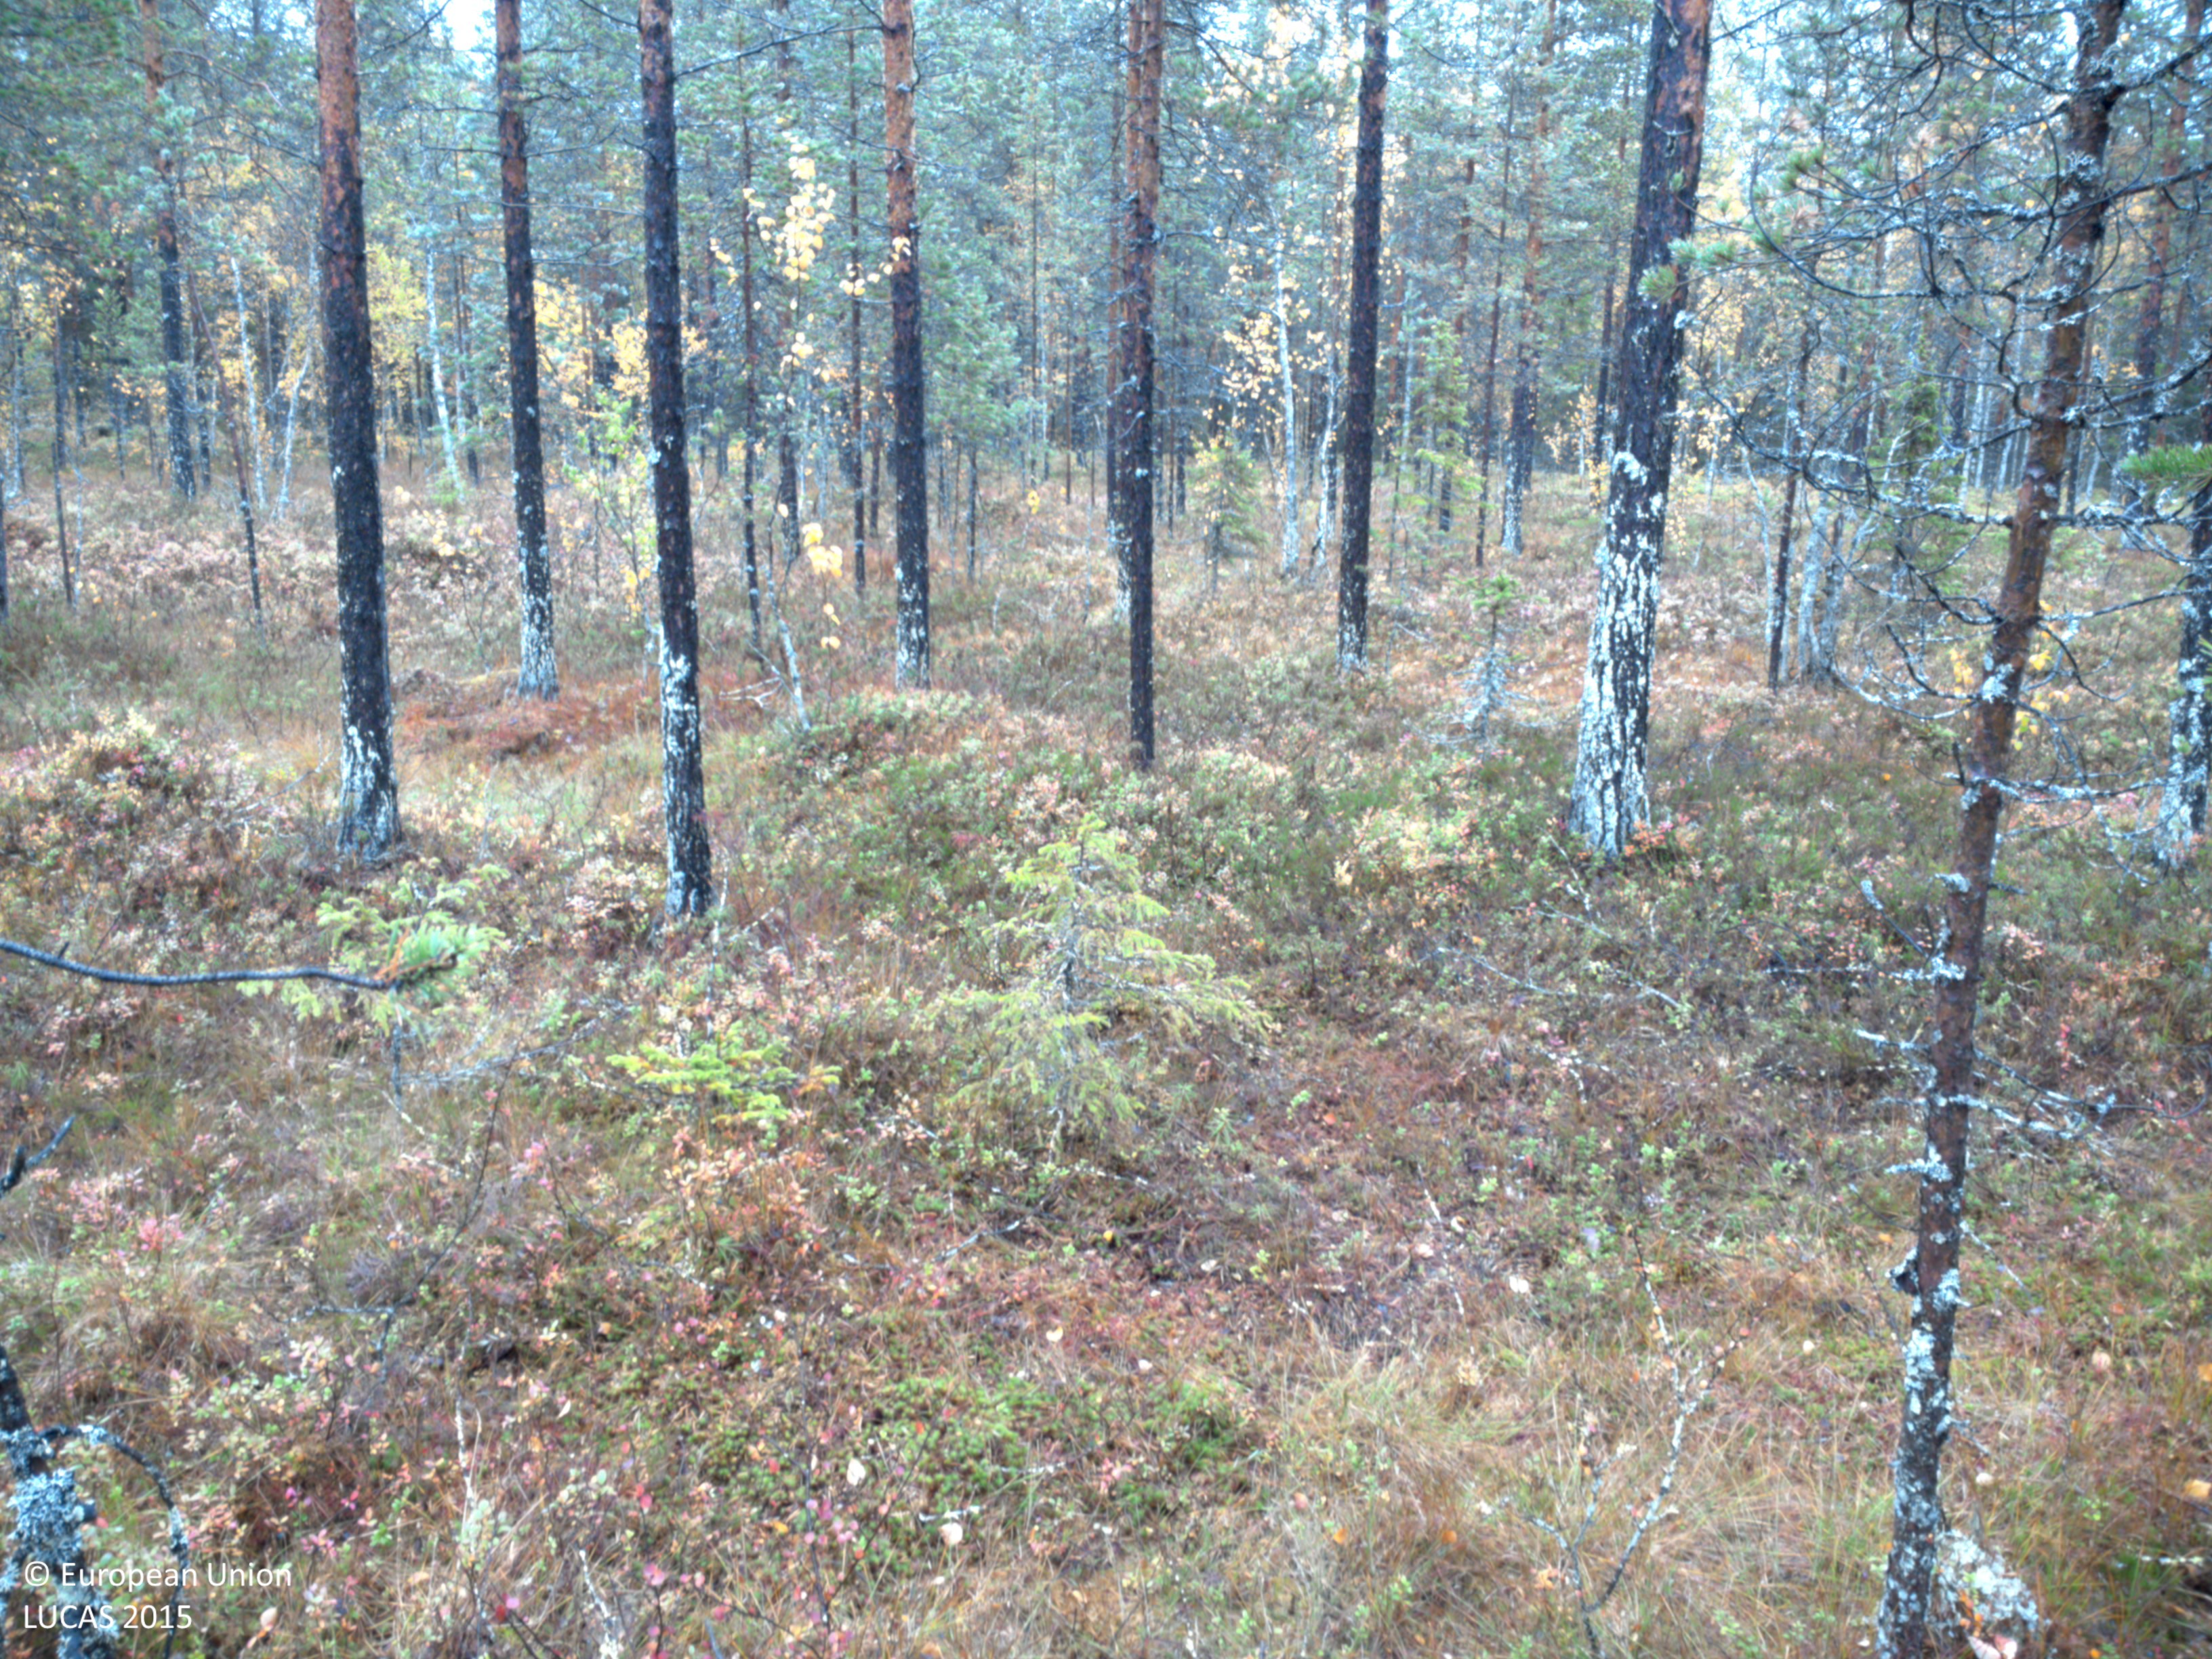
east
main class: Woodland
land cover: Pine dominated coniferous woodland
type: mire and swamp forests
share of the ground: 25 - 50 %
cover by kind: shrubs 35 %, coniferous forest trees 25 %, herbaceous plants 20 %, lichens and mosses 15 %, broadleaved forest trees 5 %
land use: Forestry
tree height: > 5 m
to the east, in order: Pine dominated coniferous woodland; Pine dominated mixed woodland; Tracks; Pine dominated mixed woodland
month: September
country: SE
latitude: 64.9718
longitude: 19.1389
